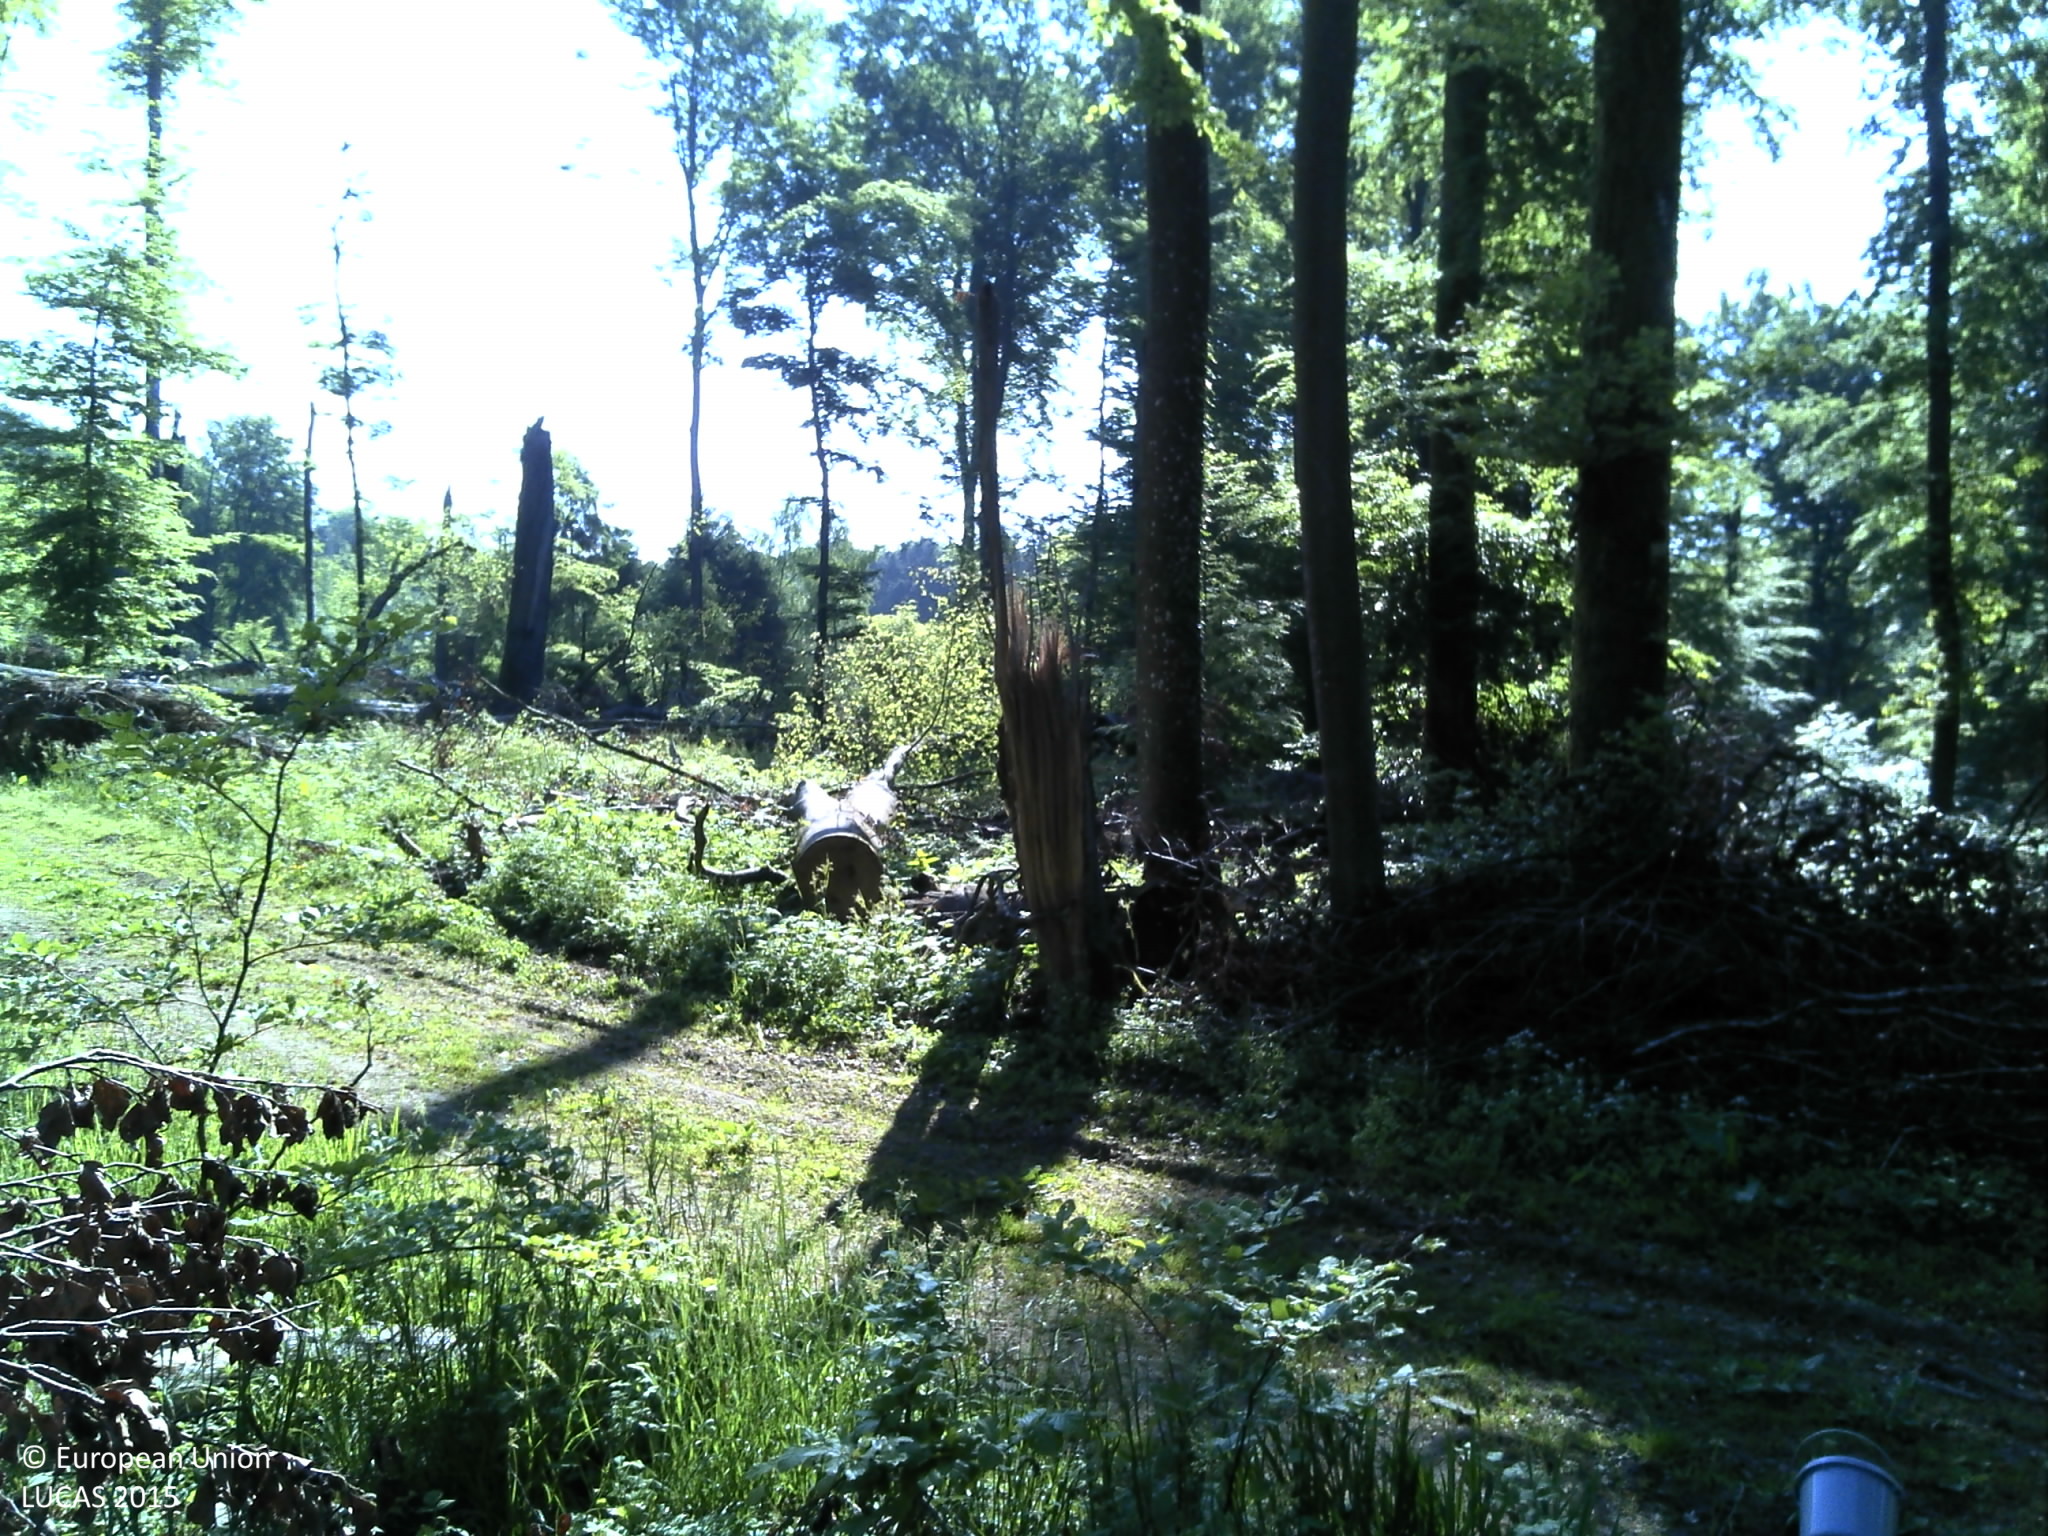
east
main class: Woodland
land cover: Broadleaved woodland
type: beech forest
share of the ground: > 75 %
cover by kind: broadleaved forest trees 100 %
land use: Forestry
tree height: > 5 m
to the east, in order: Broadleaved woodland; Tracks; Broadleaved woodland; Other bare soil; Shrubland without tree cover; Broadleaved woodland; Shrubland without tree cover
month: May
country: LU
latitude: 49.6808
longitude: 5.9661
